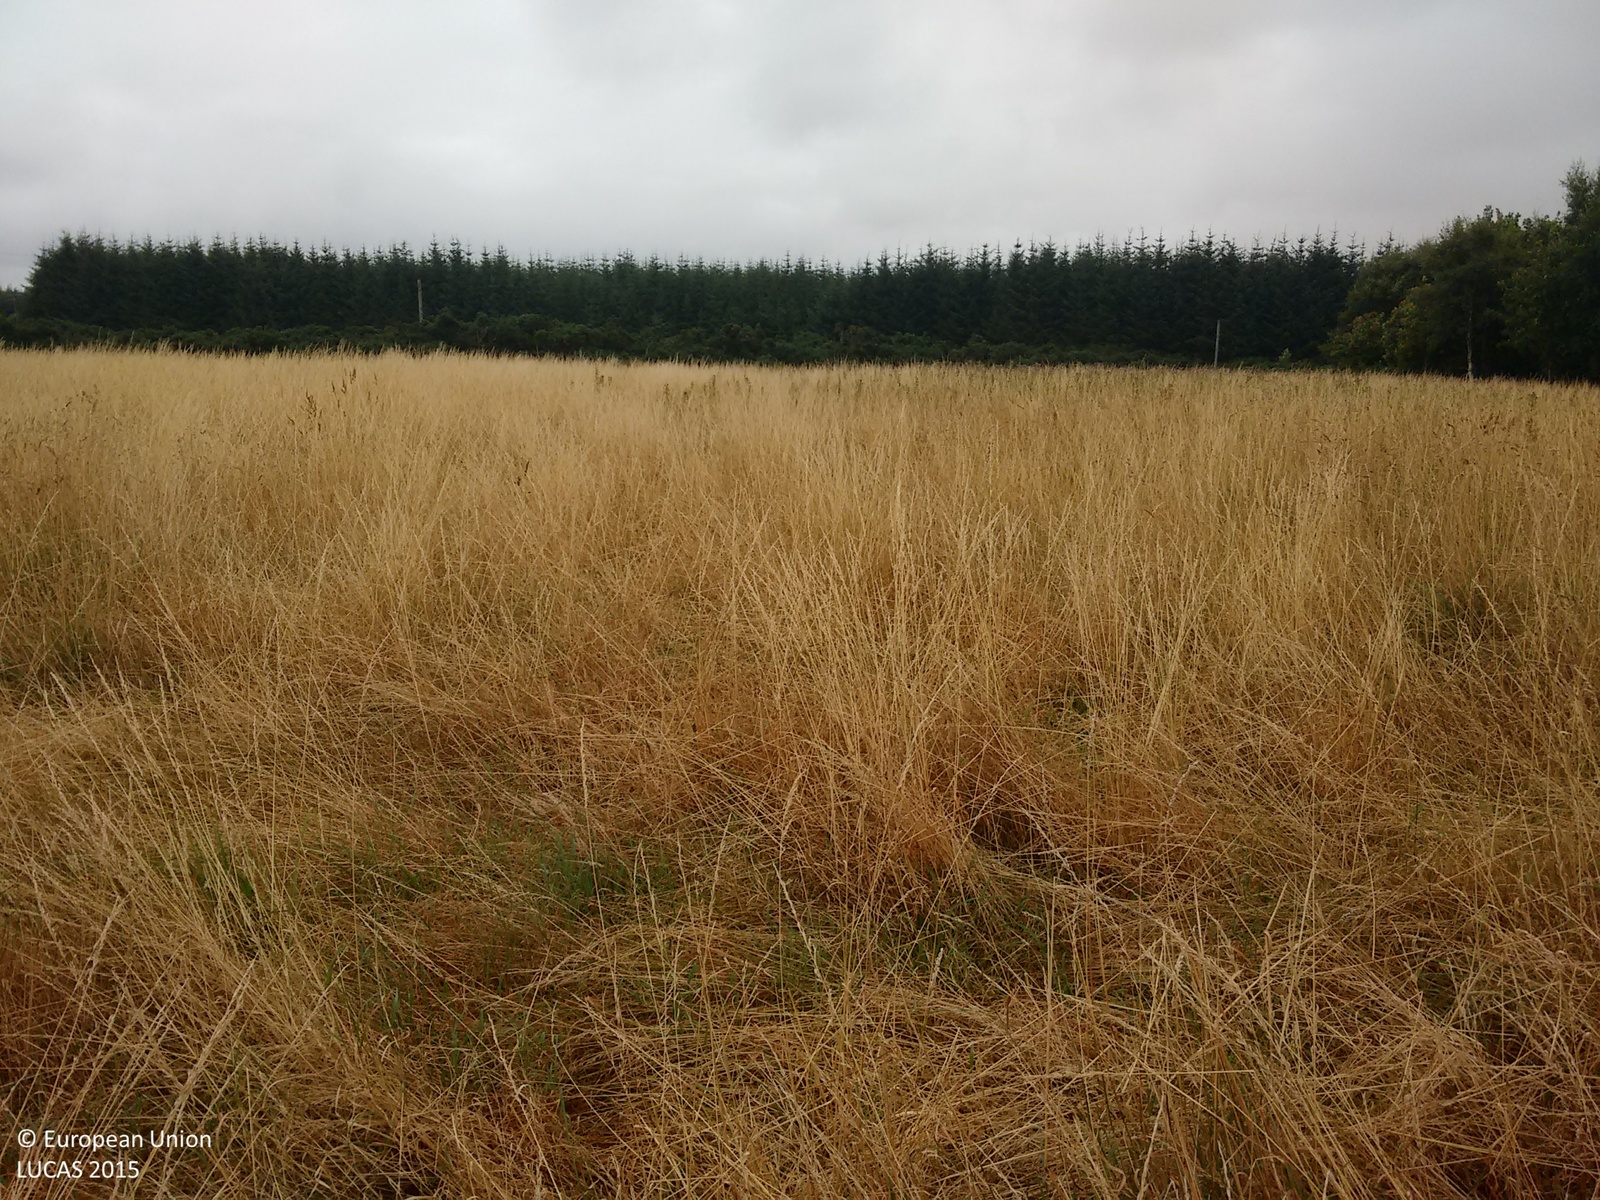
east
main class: Grassland
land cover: Grassland without tree/shrub cover
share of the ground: > 75 %
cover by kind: herbaceous plants 100 %
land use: Agriculture (excluding fallow land and kitchen gardens)
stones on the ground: 10 - 25 %
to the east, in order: Grassland without tree/shrub cover; Electric lines; Shrubland without tree cover; Fences; Grass margins; Paved roads, cycling and walking lanes; Shrubland without tree cover; Grassland without tree/shrub cover; Spruce dominated coniferous woodland
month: September
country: GB
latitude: 57.6867
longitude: -2.8896
